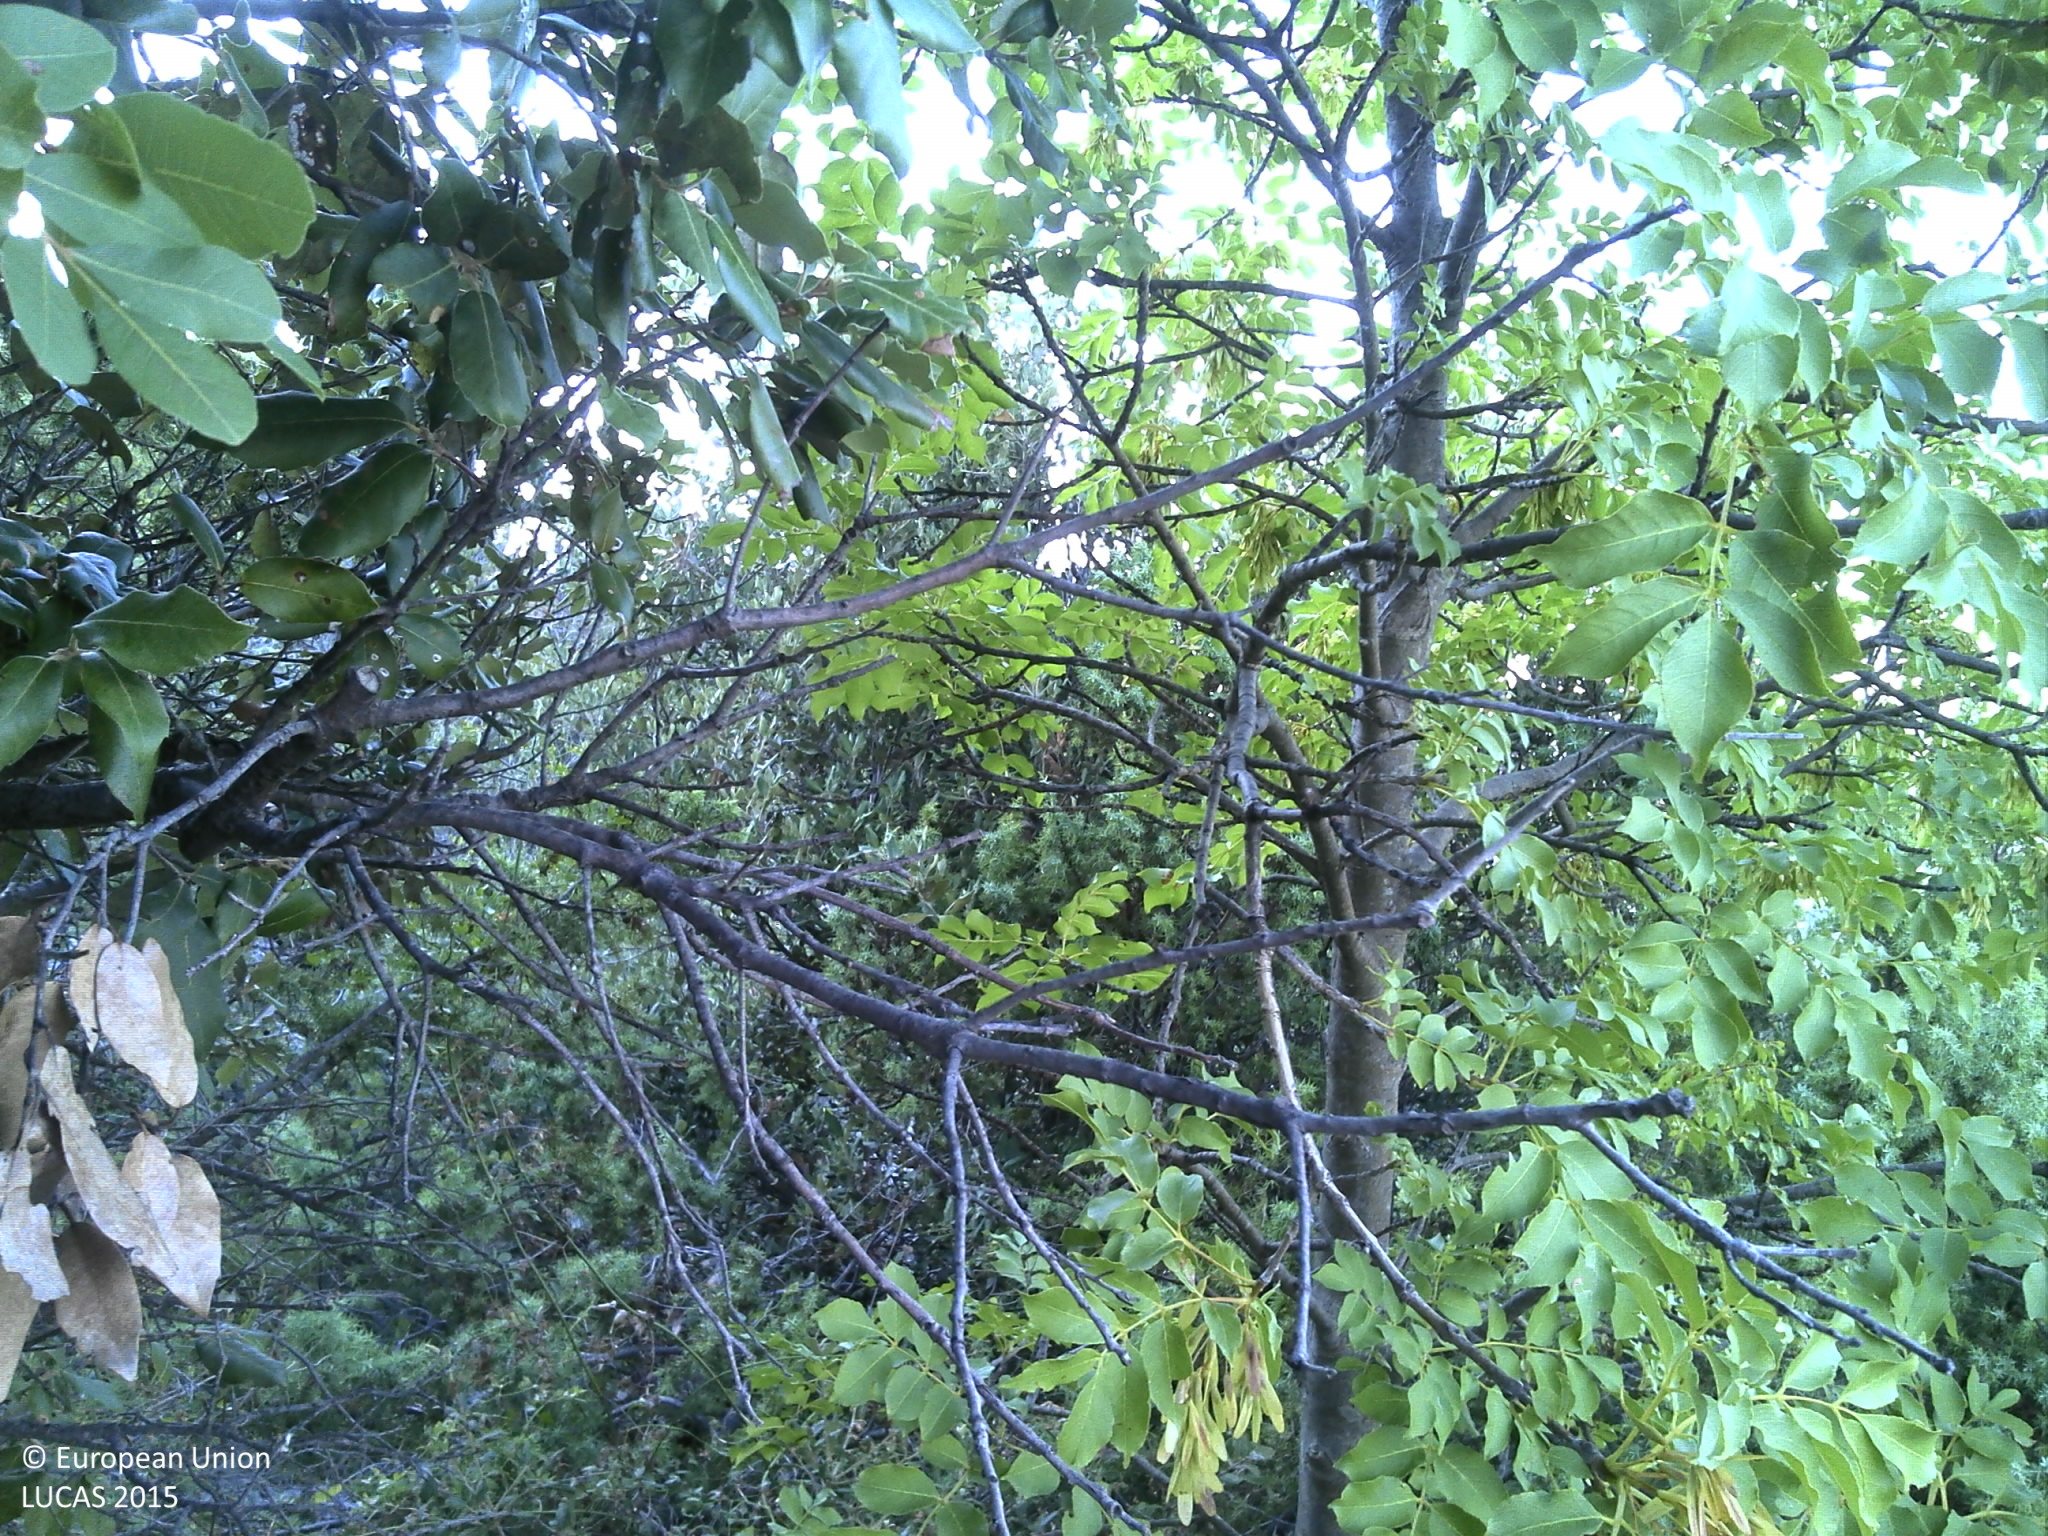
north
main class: Woodland
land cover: Broadleaved woodland
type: thermophilous deciduous forest
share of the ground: 25 - 50 %
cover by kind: broadleaved forest trees 40 %, shrubs 25 %, consolidated bare surface 25 %, coniferous forest trees 5 %, unconsolidated bare surface 5 %
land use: Semi-natural and natural areas not in use
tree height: > 5 m
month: September
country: HR
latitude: 43.8528
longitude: 15.9753
